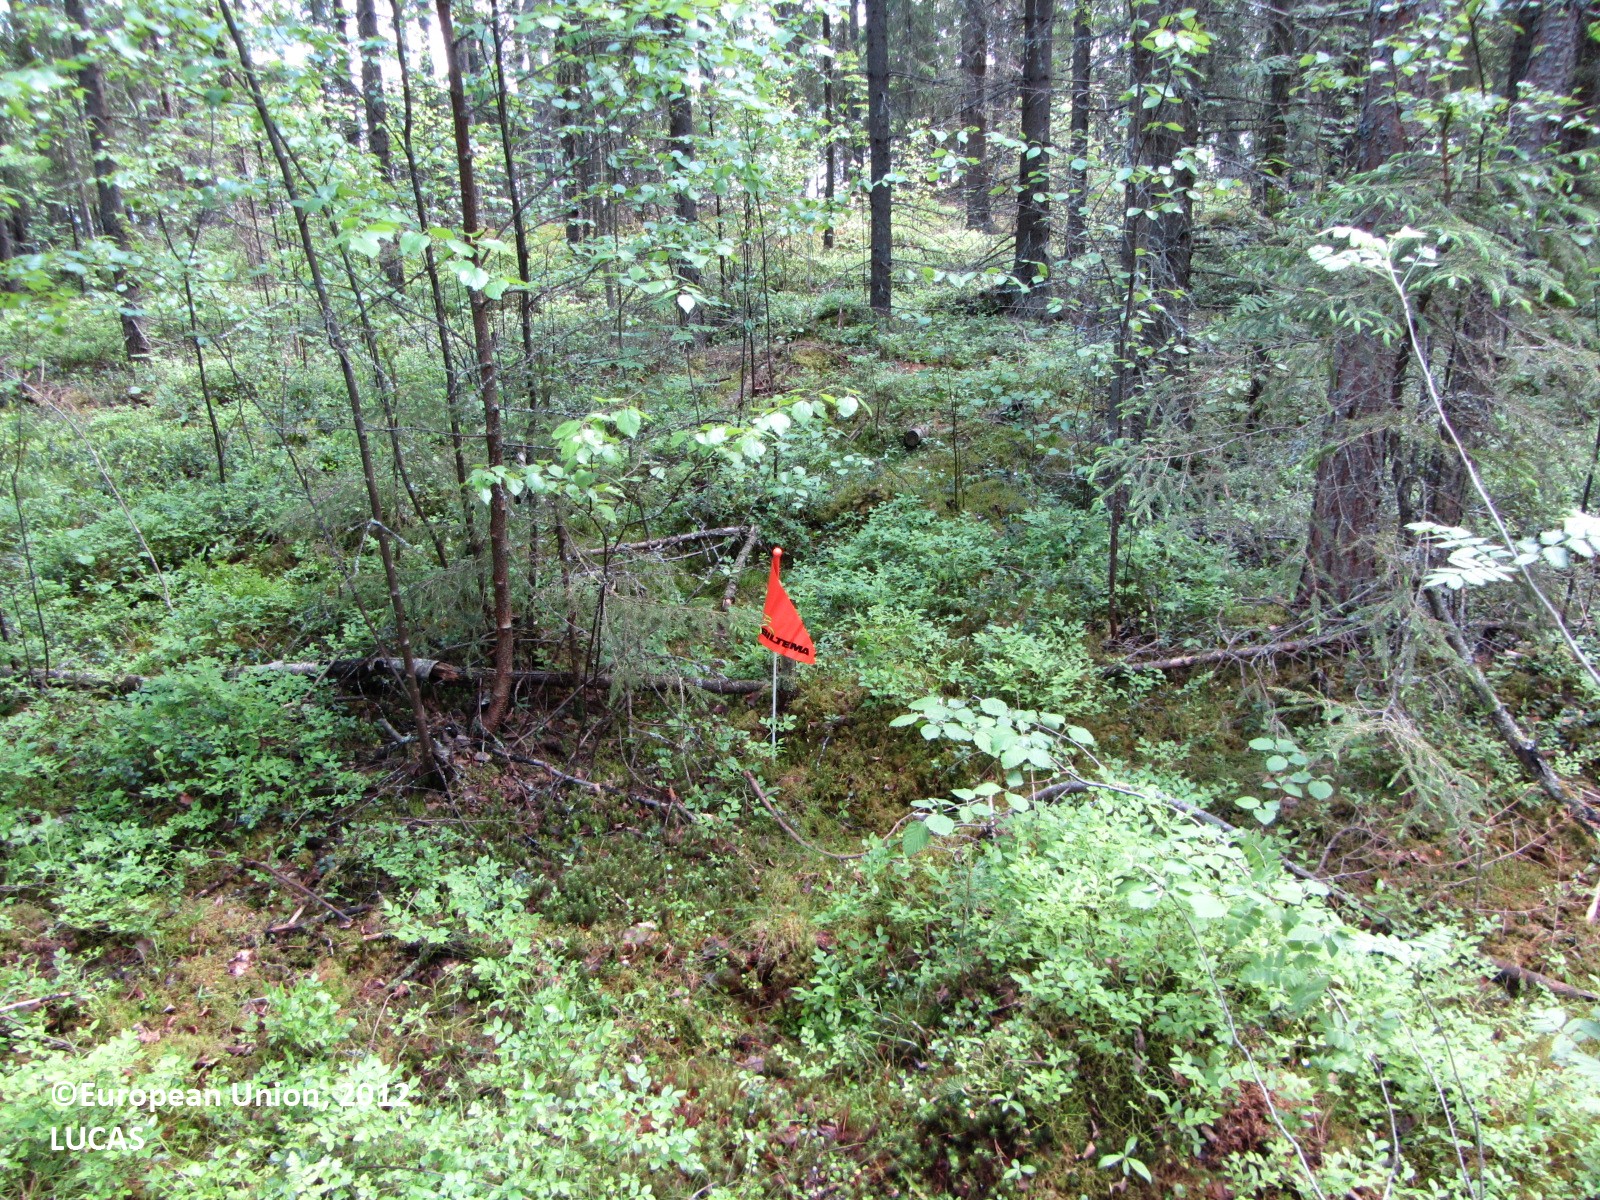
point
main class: Woodland
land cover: Spruce dominated mixed woodland
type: boreal forest
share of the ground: 50 - 75 %
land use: Forestry
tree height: > 5 m
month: June
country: FI
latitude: 62.0253
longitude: 24.9519
